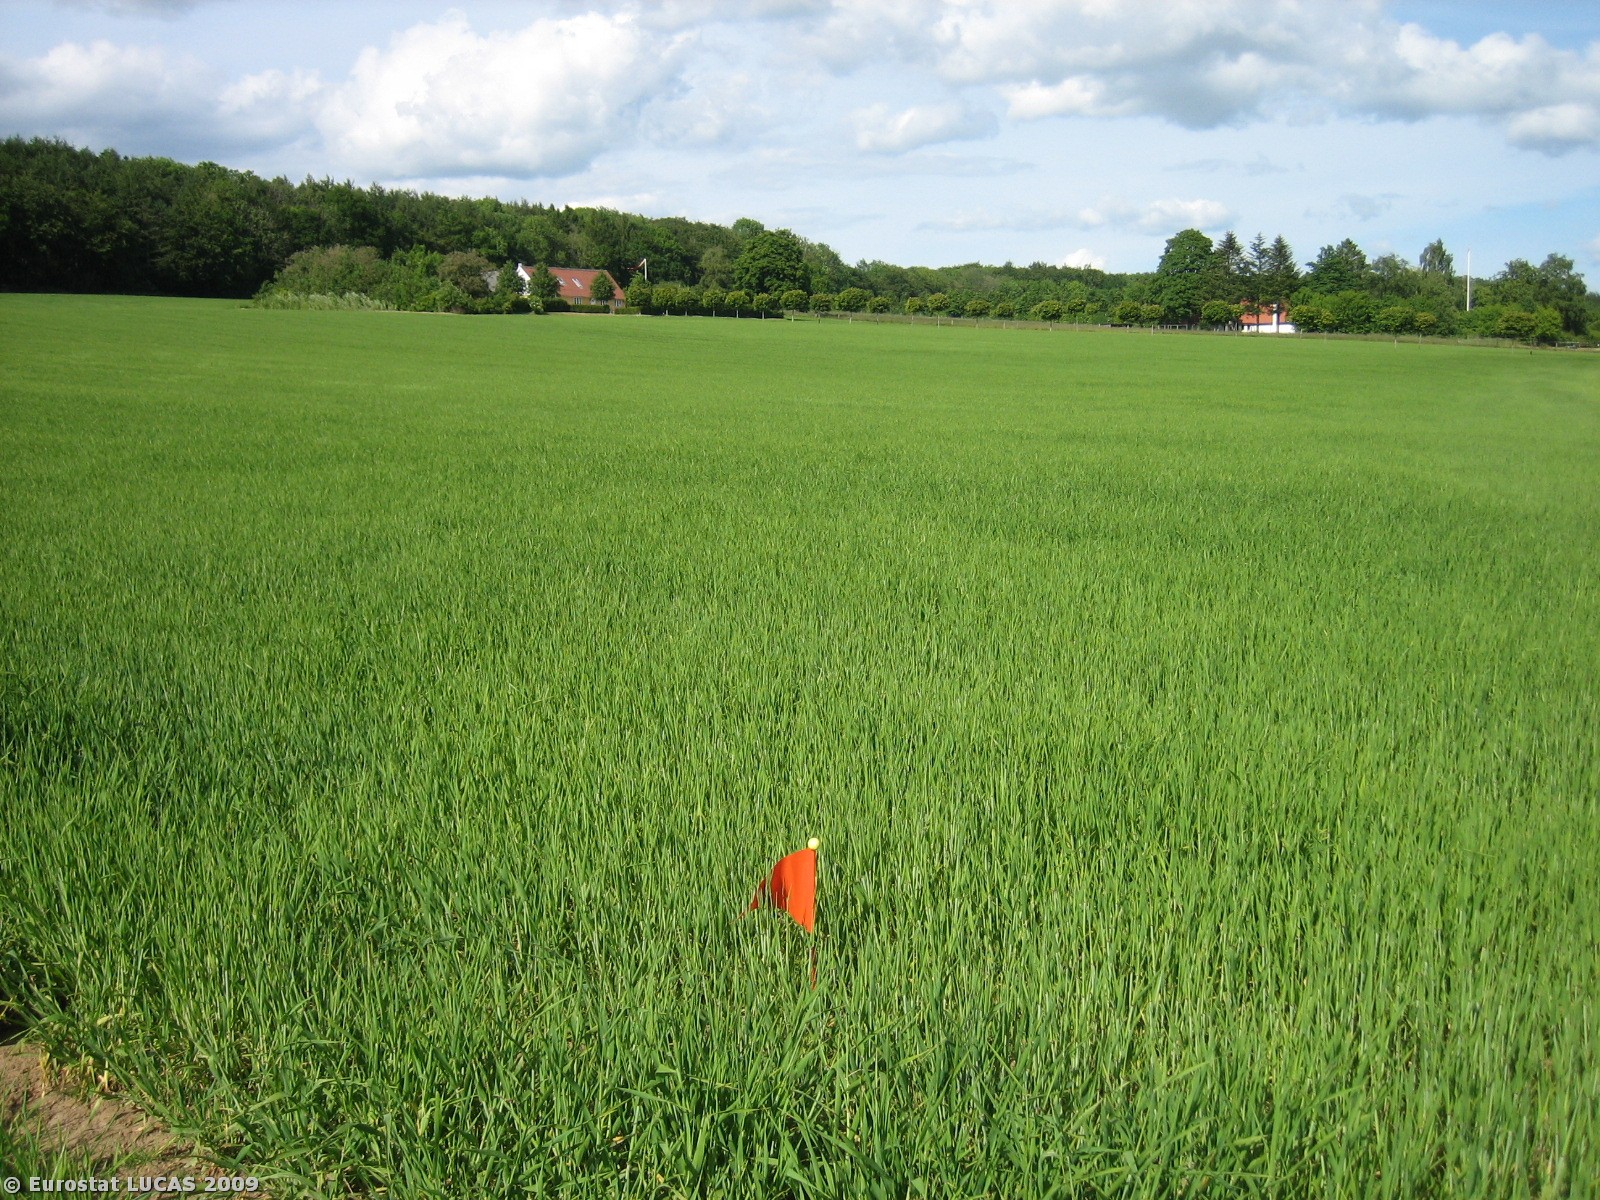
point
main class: Cropland
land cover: Barley
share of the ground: > 75 %
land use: Agriculture (excluding fallow land and kitchen gardens)
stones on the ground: < 10 %
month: June
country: DK
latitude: 56.1877
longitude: 9.8873
